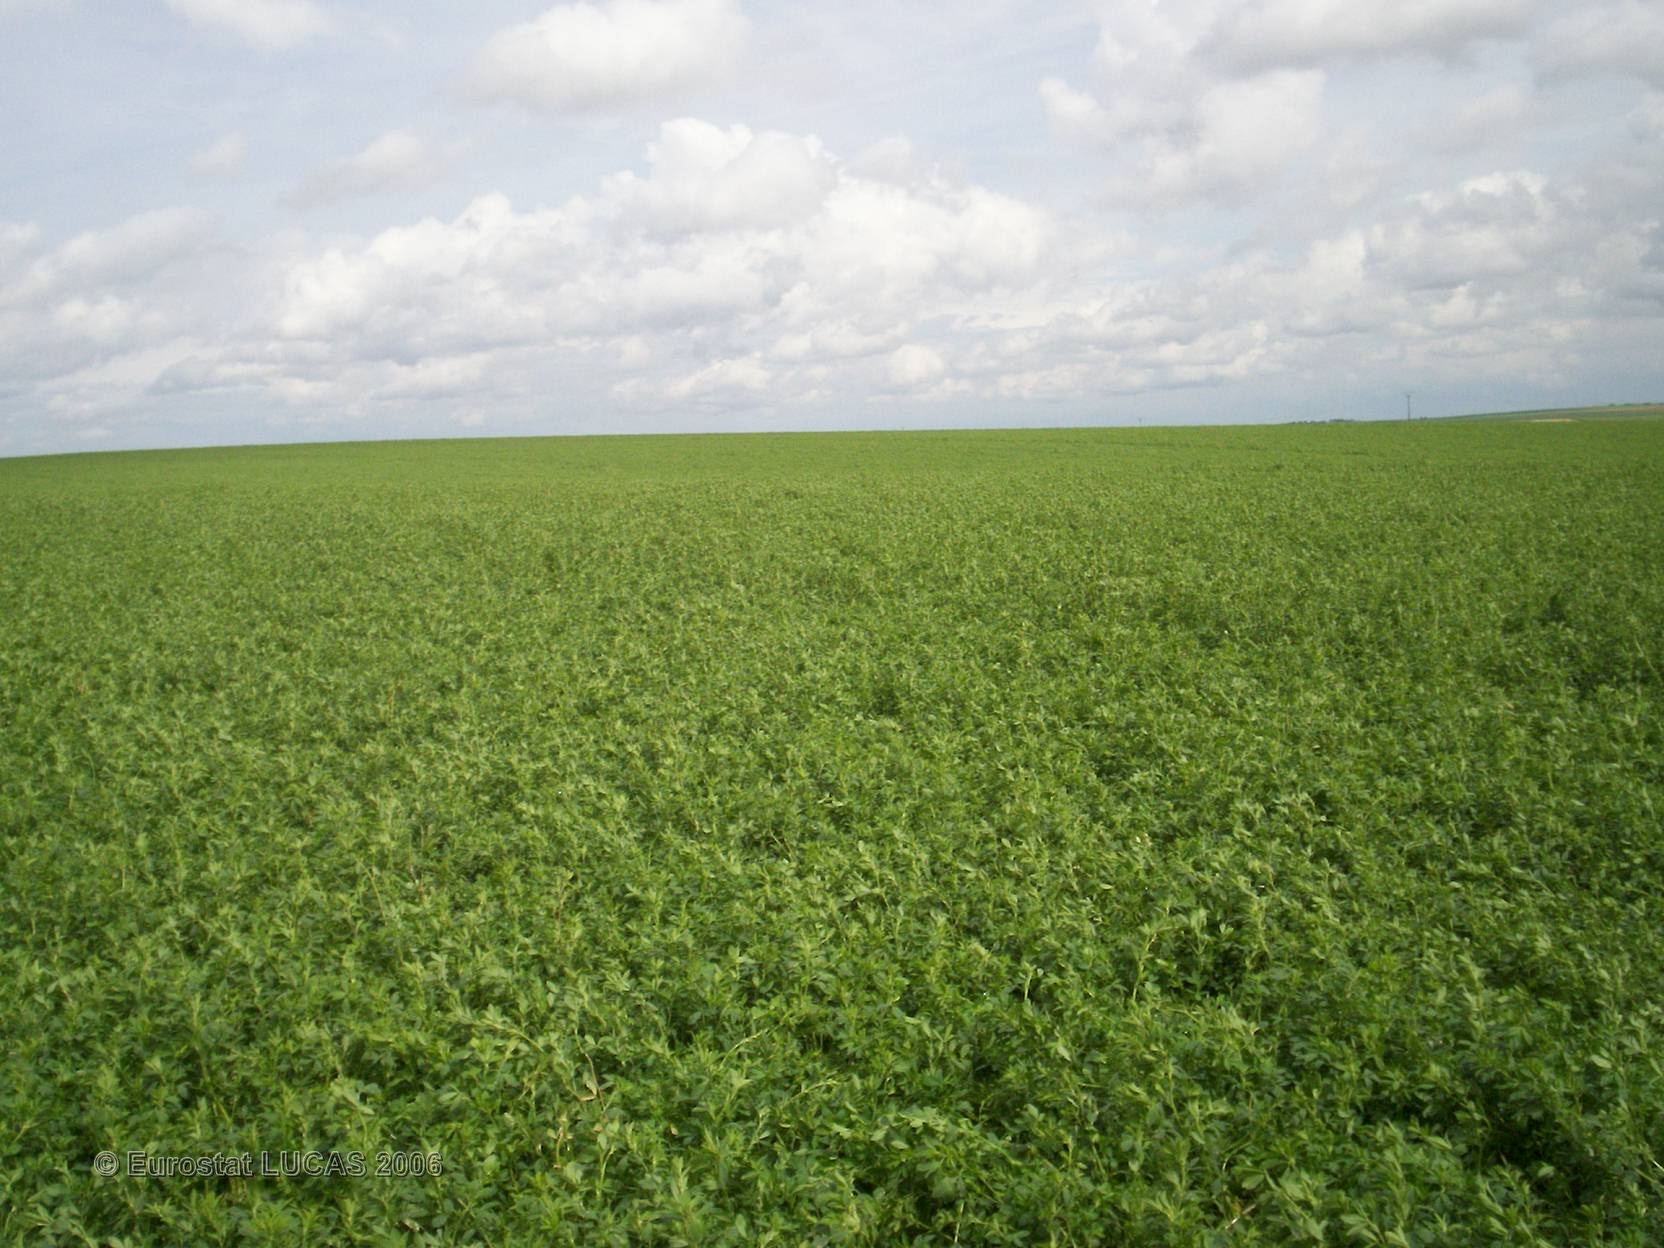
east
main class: Cropland
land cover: Lucerne
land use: Agriculture (excluding fallow land and kitchen gardens)
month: May
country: FR
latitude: 49.4660
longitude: 4.3246
